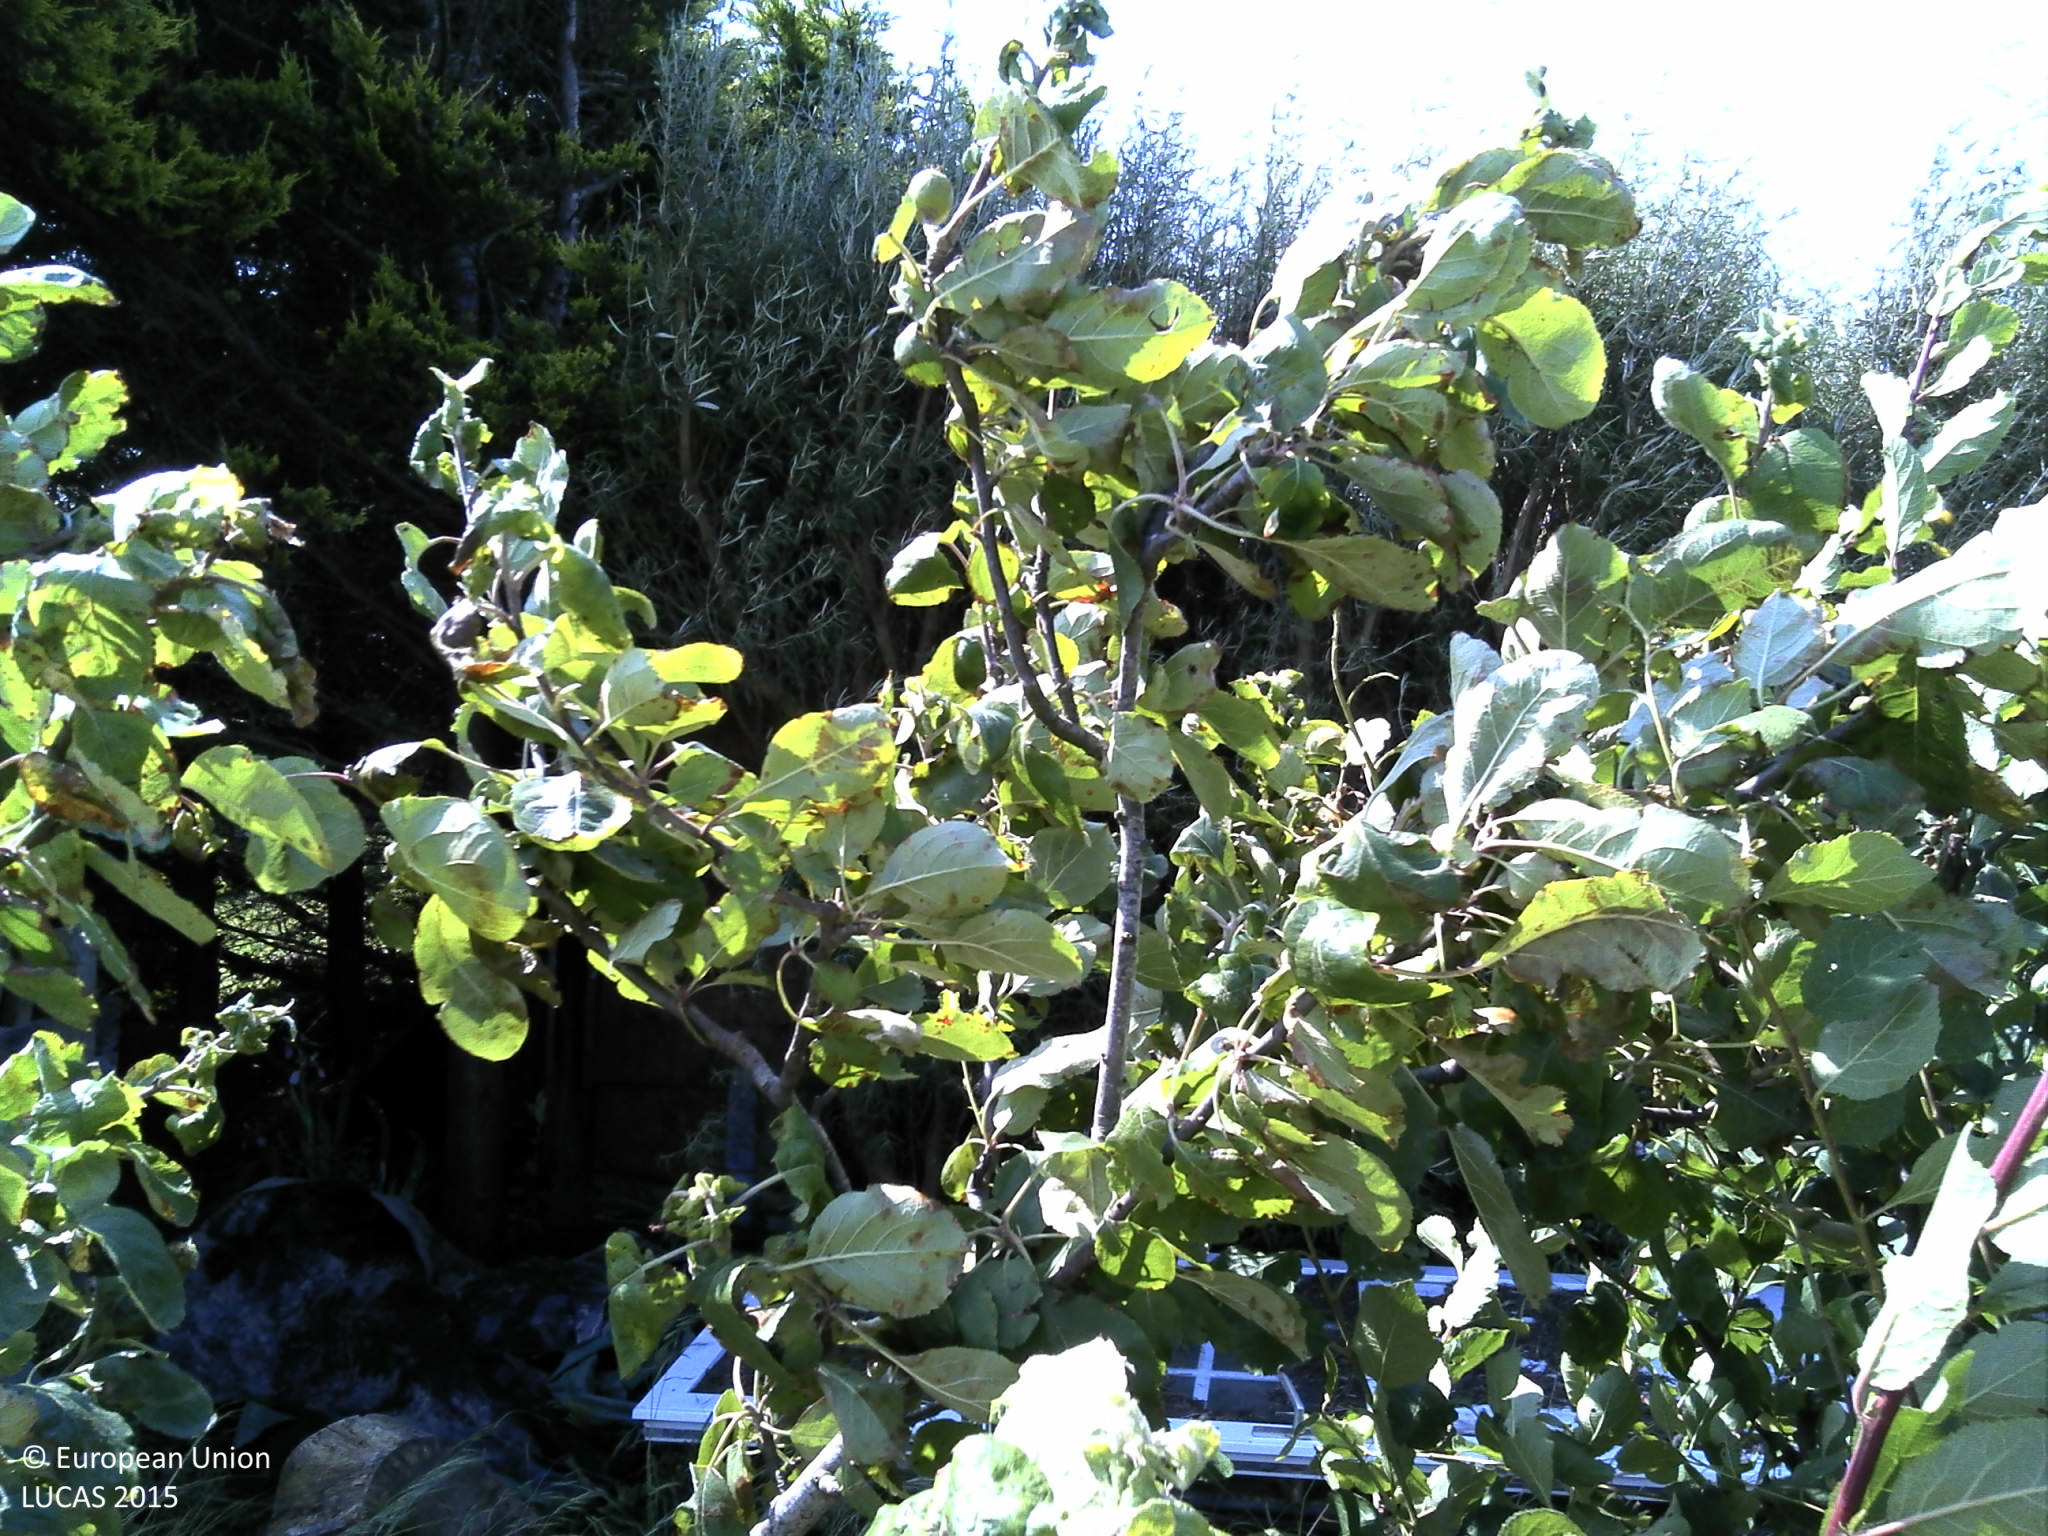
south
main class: Cropland
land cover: Other fresh vegetables
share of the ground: > 75 %
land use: Fallow land
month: June
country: FR
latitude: 47.9788
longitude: -4.4435
